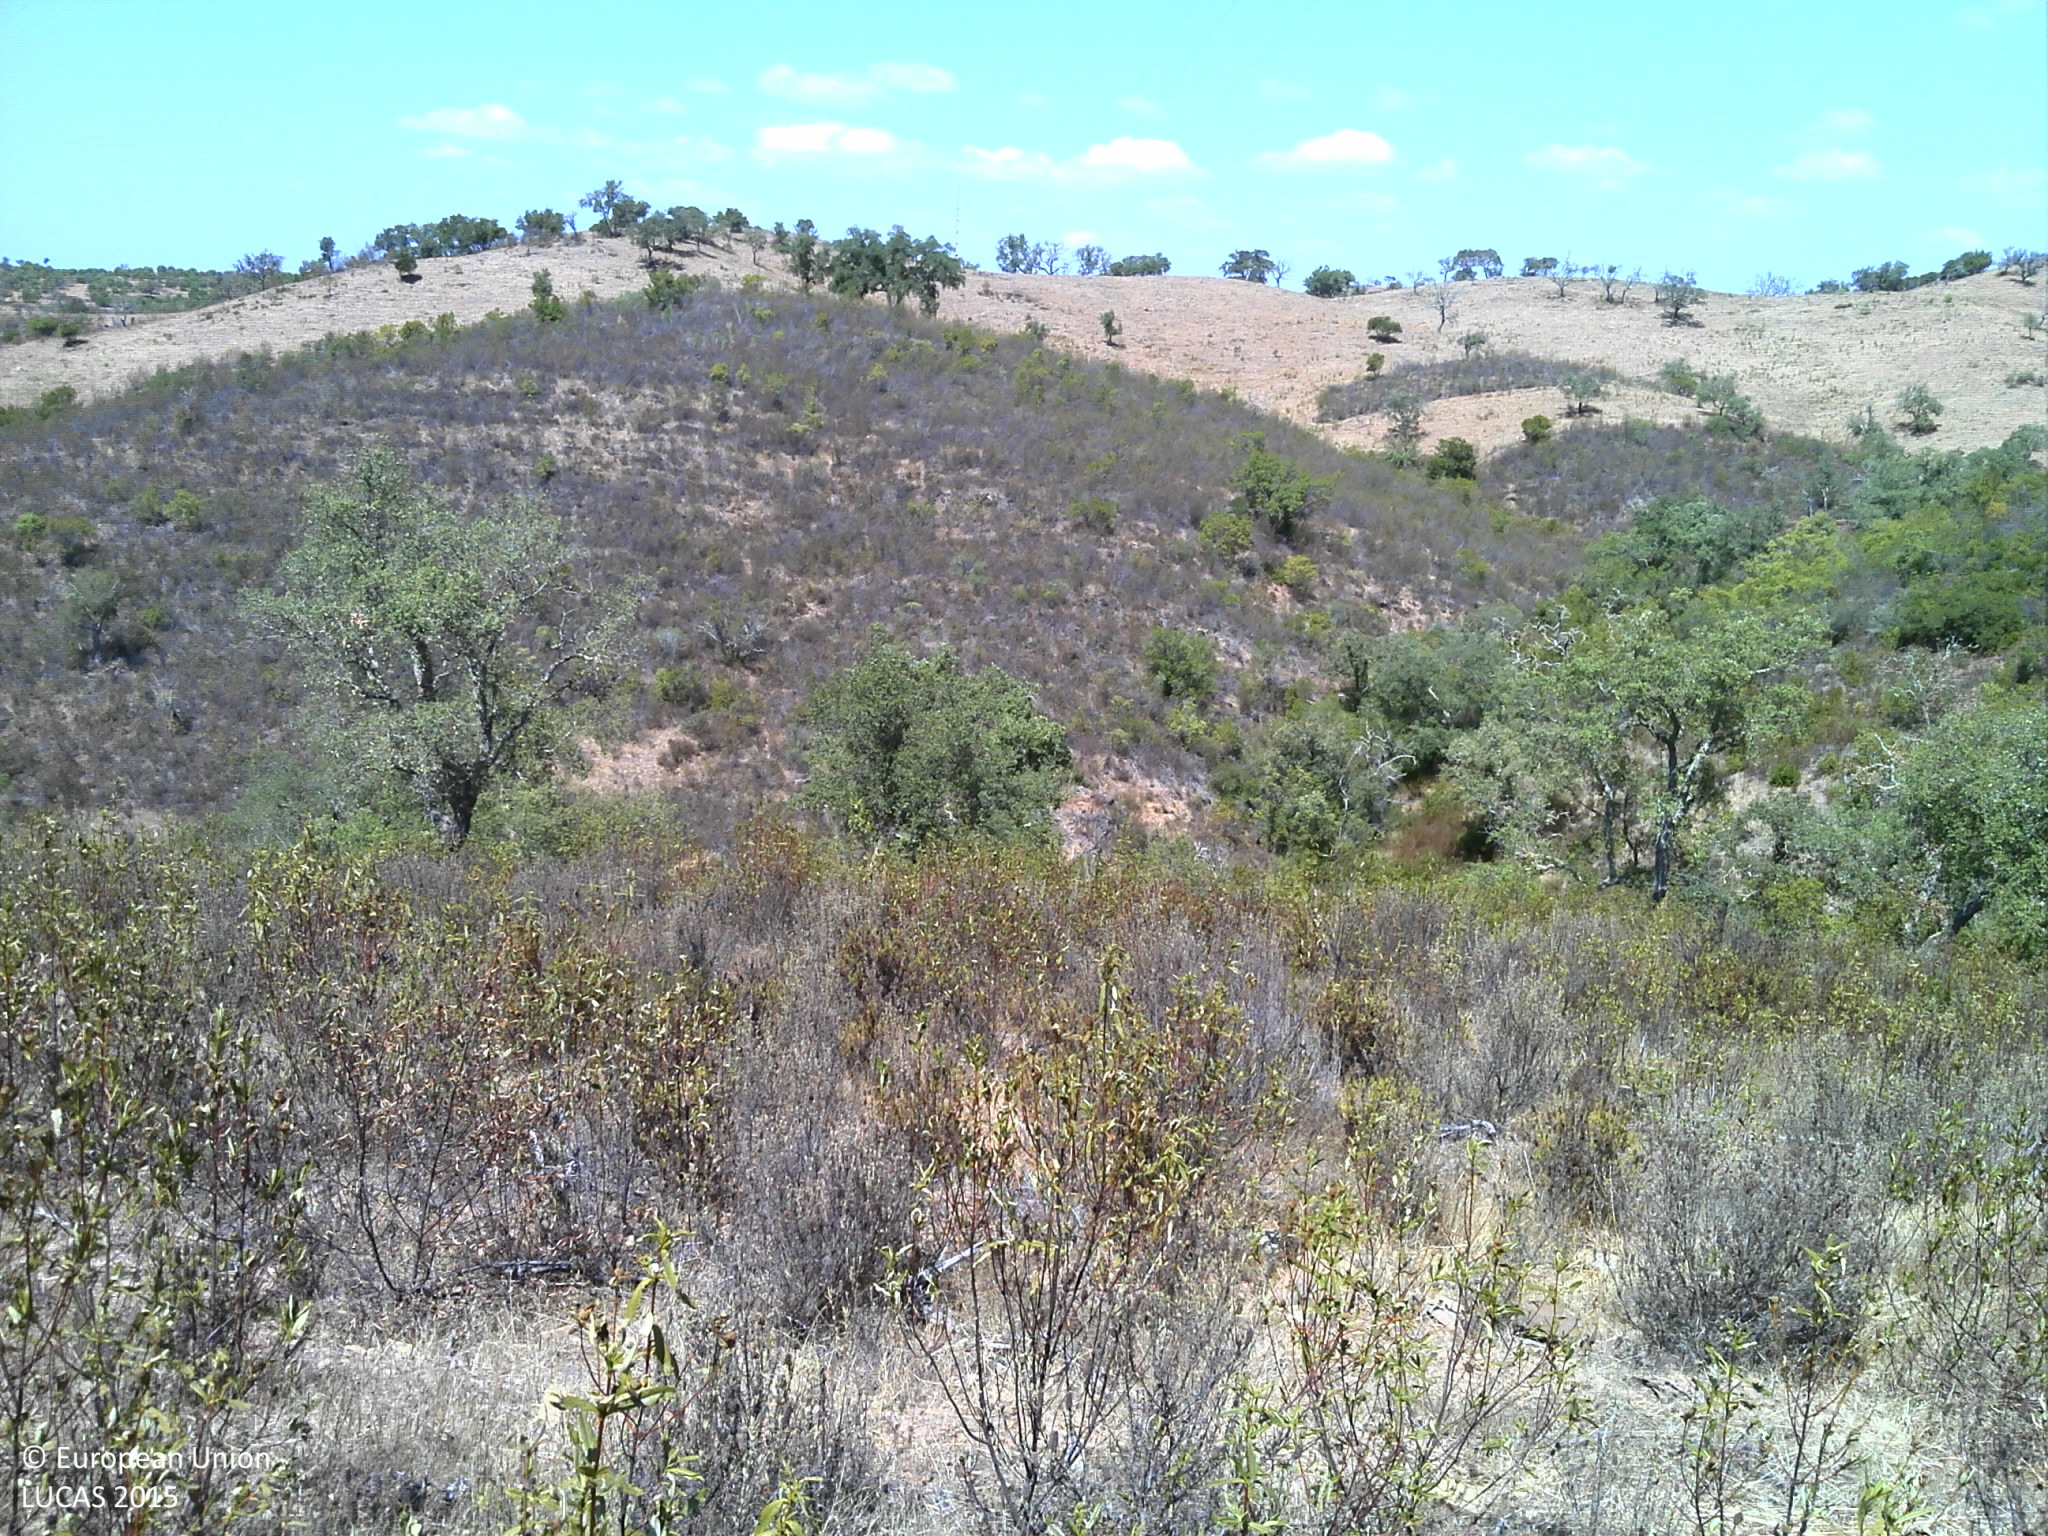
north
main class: Shrubland
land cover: Shrubland with sparse tree cover
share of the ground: 50 - 75 %
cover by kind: shrubs 60 %, unconsolidated bare surface 35 %, broadleaved forest trees 5 %
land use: Forestry
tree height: < 5 m
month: September
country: PT
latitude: 37.4852
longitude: -8.2452
